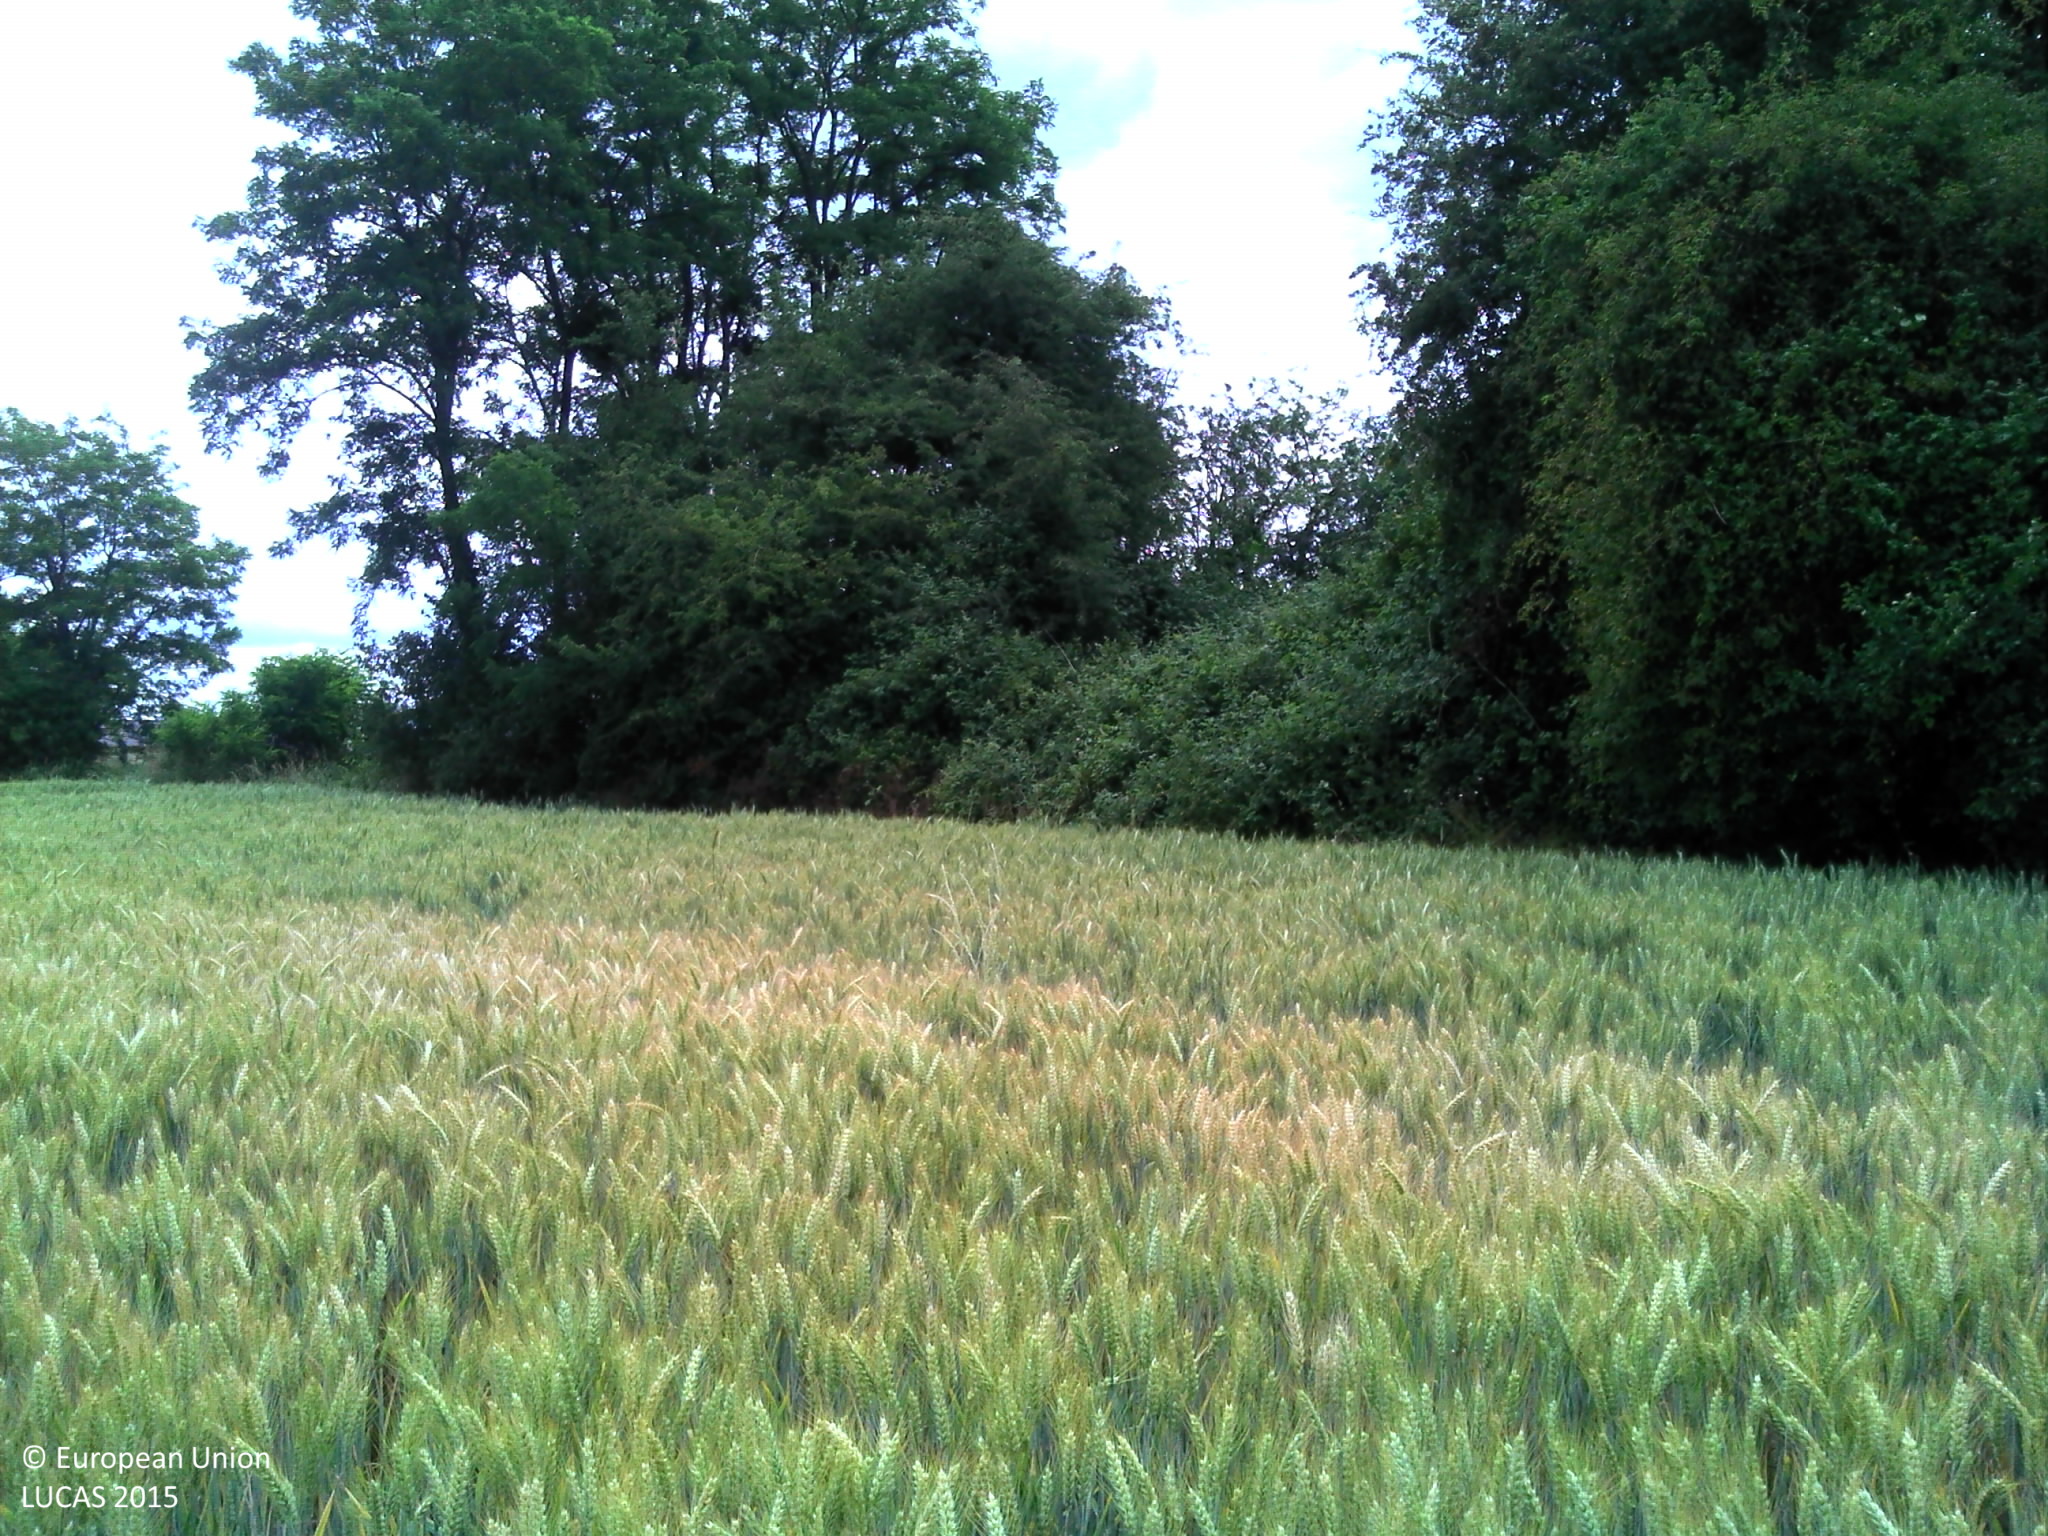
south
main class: Cropland
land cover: Common wheat
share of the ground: > 75 %
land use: Agriculture (excluding fallow land and kitchen gardens)
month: June
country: FR
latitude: 49.0524
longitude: 1.2642
